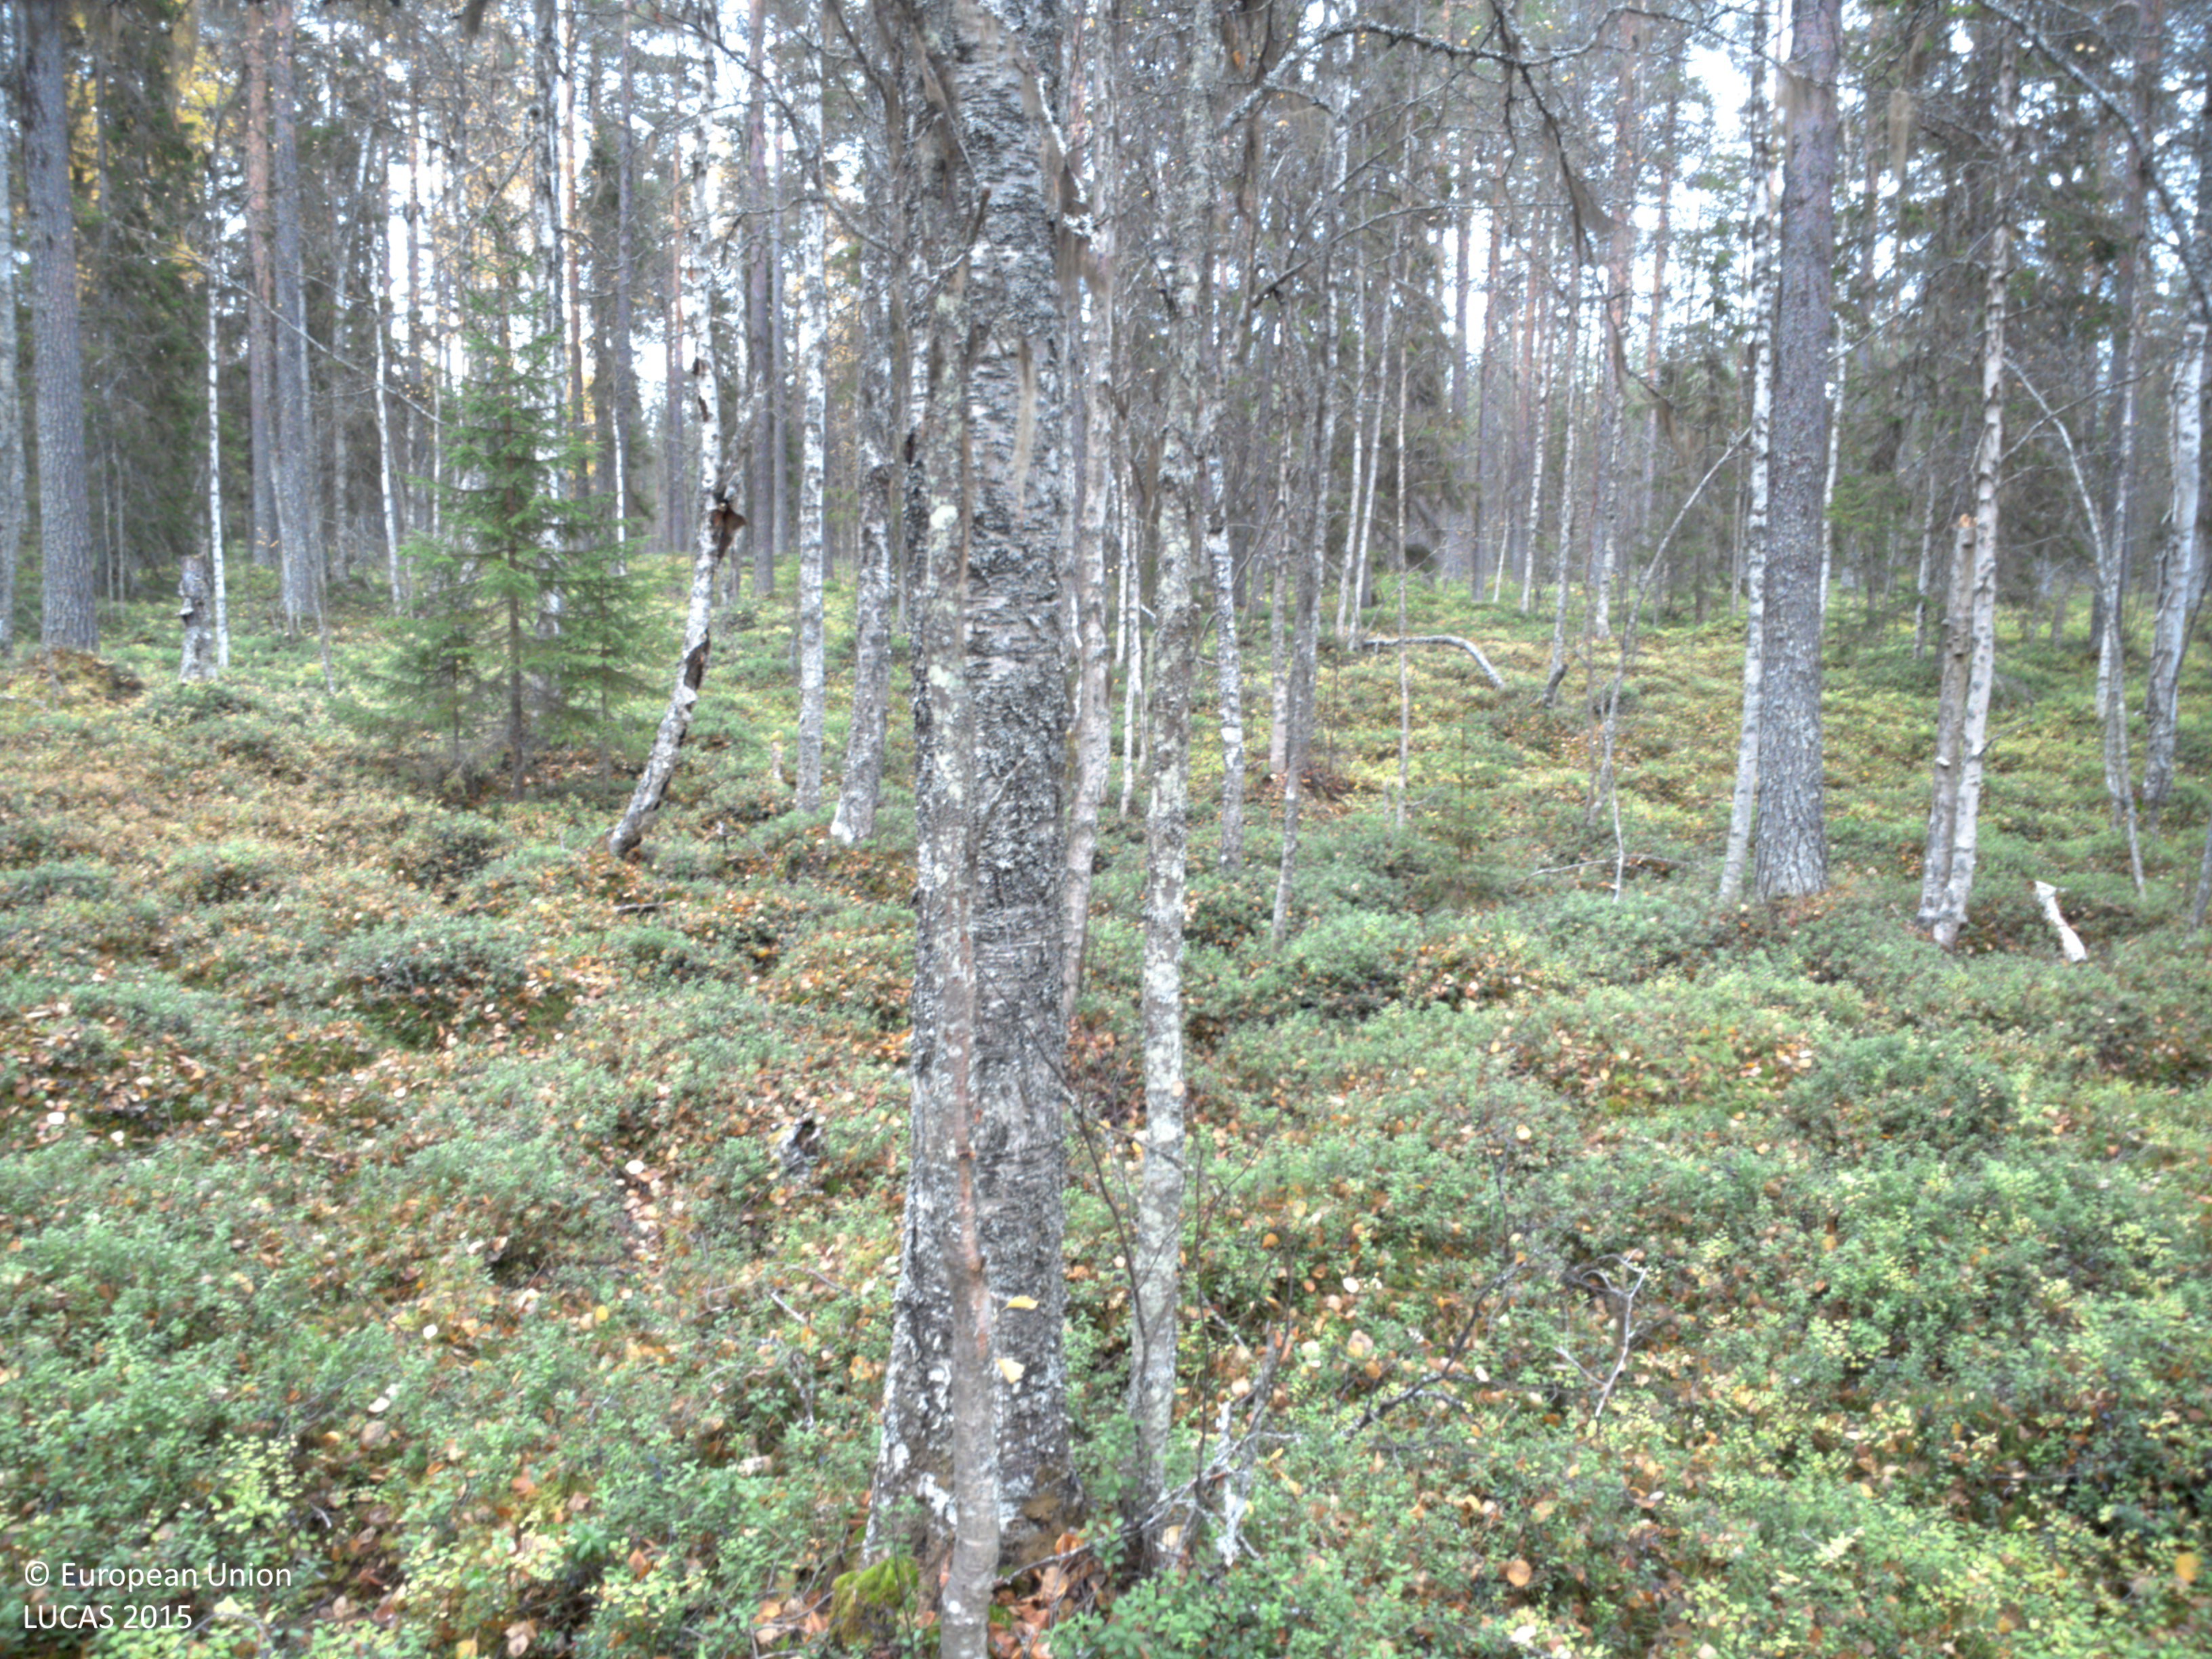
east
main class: Woodland
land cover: Pine dominated mixed woodland
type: boreal forest
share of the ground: 50 - 75 %
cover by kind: coniferous forest trees 50 %, broadleaved forest trees 25 %, shrubs 15 %, lichens and mosses 10 %
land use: Forestry
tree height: > 5 m
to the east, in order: Pine dominated mixed woodland; Pine dominated coniferous woodland
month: October
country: SE
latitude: 64.7882
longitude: 18.1502
